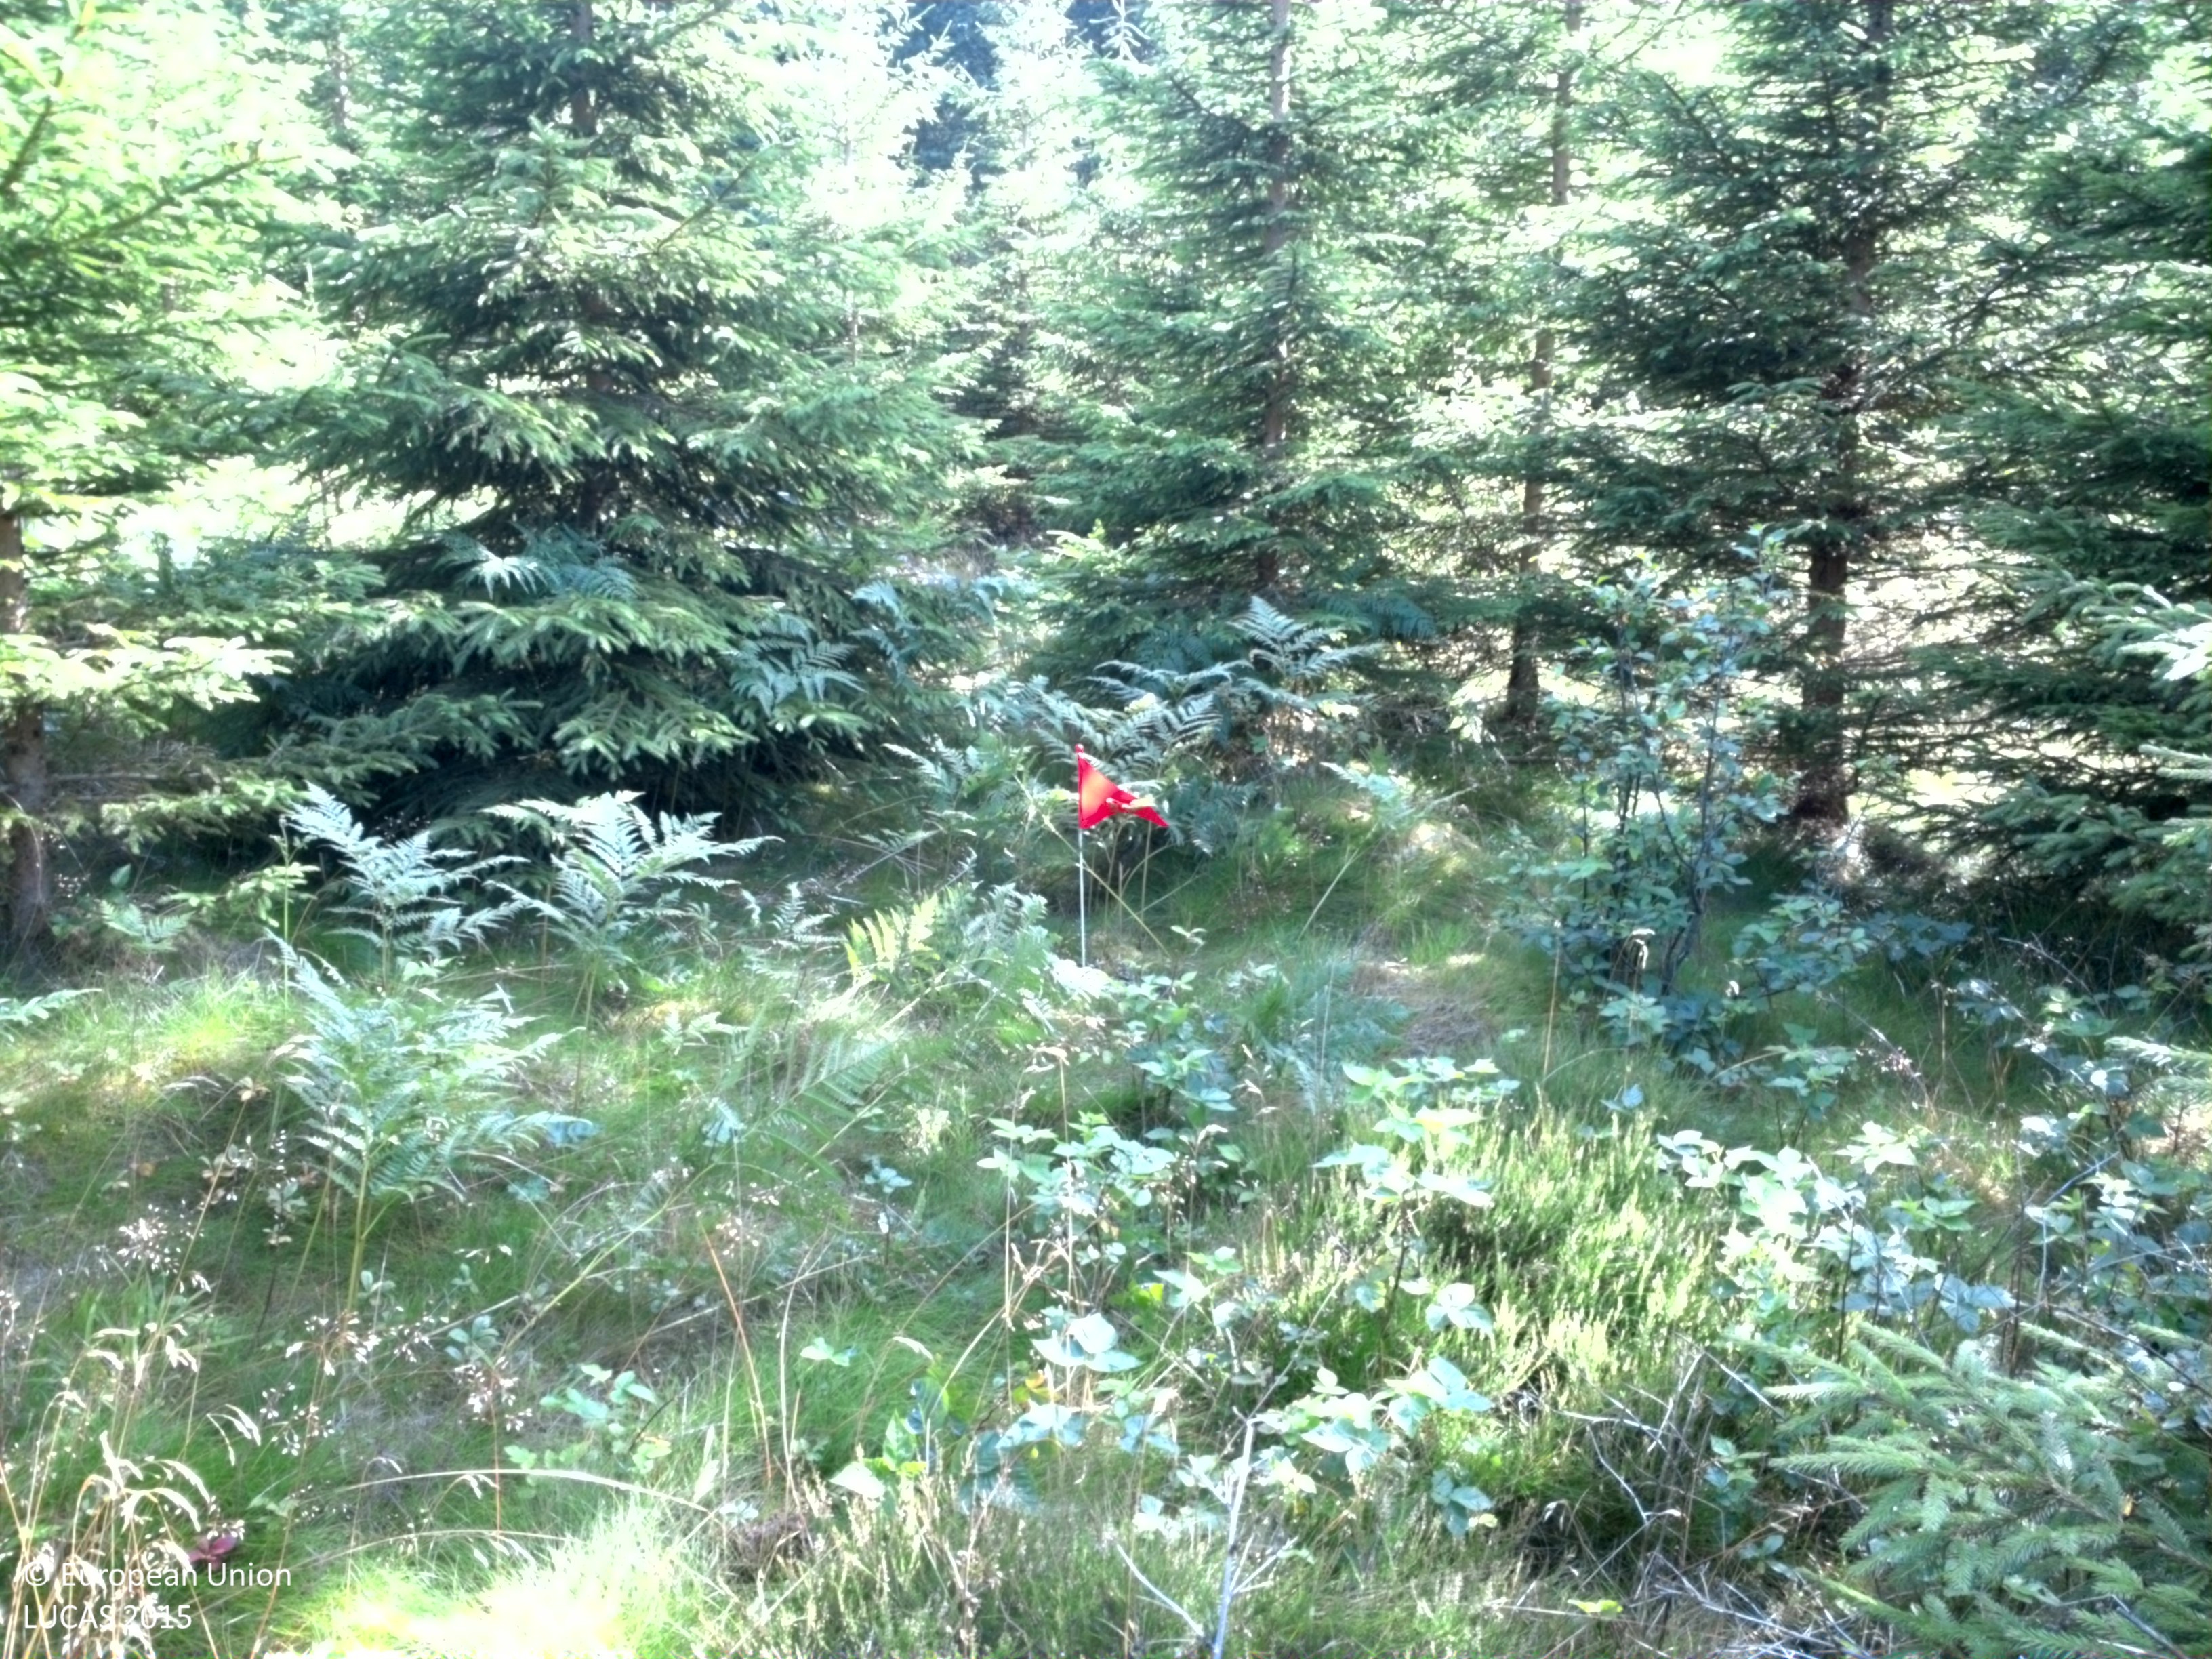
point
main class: Woodland
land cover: Spruce dominated coniferous woodland
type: boreal forest
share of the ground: 50 - 75 %
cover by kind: coniferous forest trees 50 %, lichens and mosses 30 %, herbaceous plants 20 %
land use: Forestry
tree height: < 5 m
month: August
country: SE
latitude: 58.1065
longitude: 13.9822
